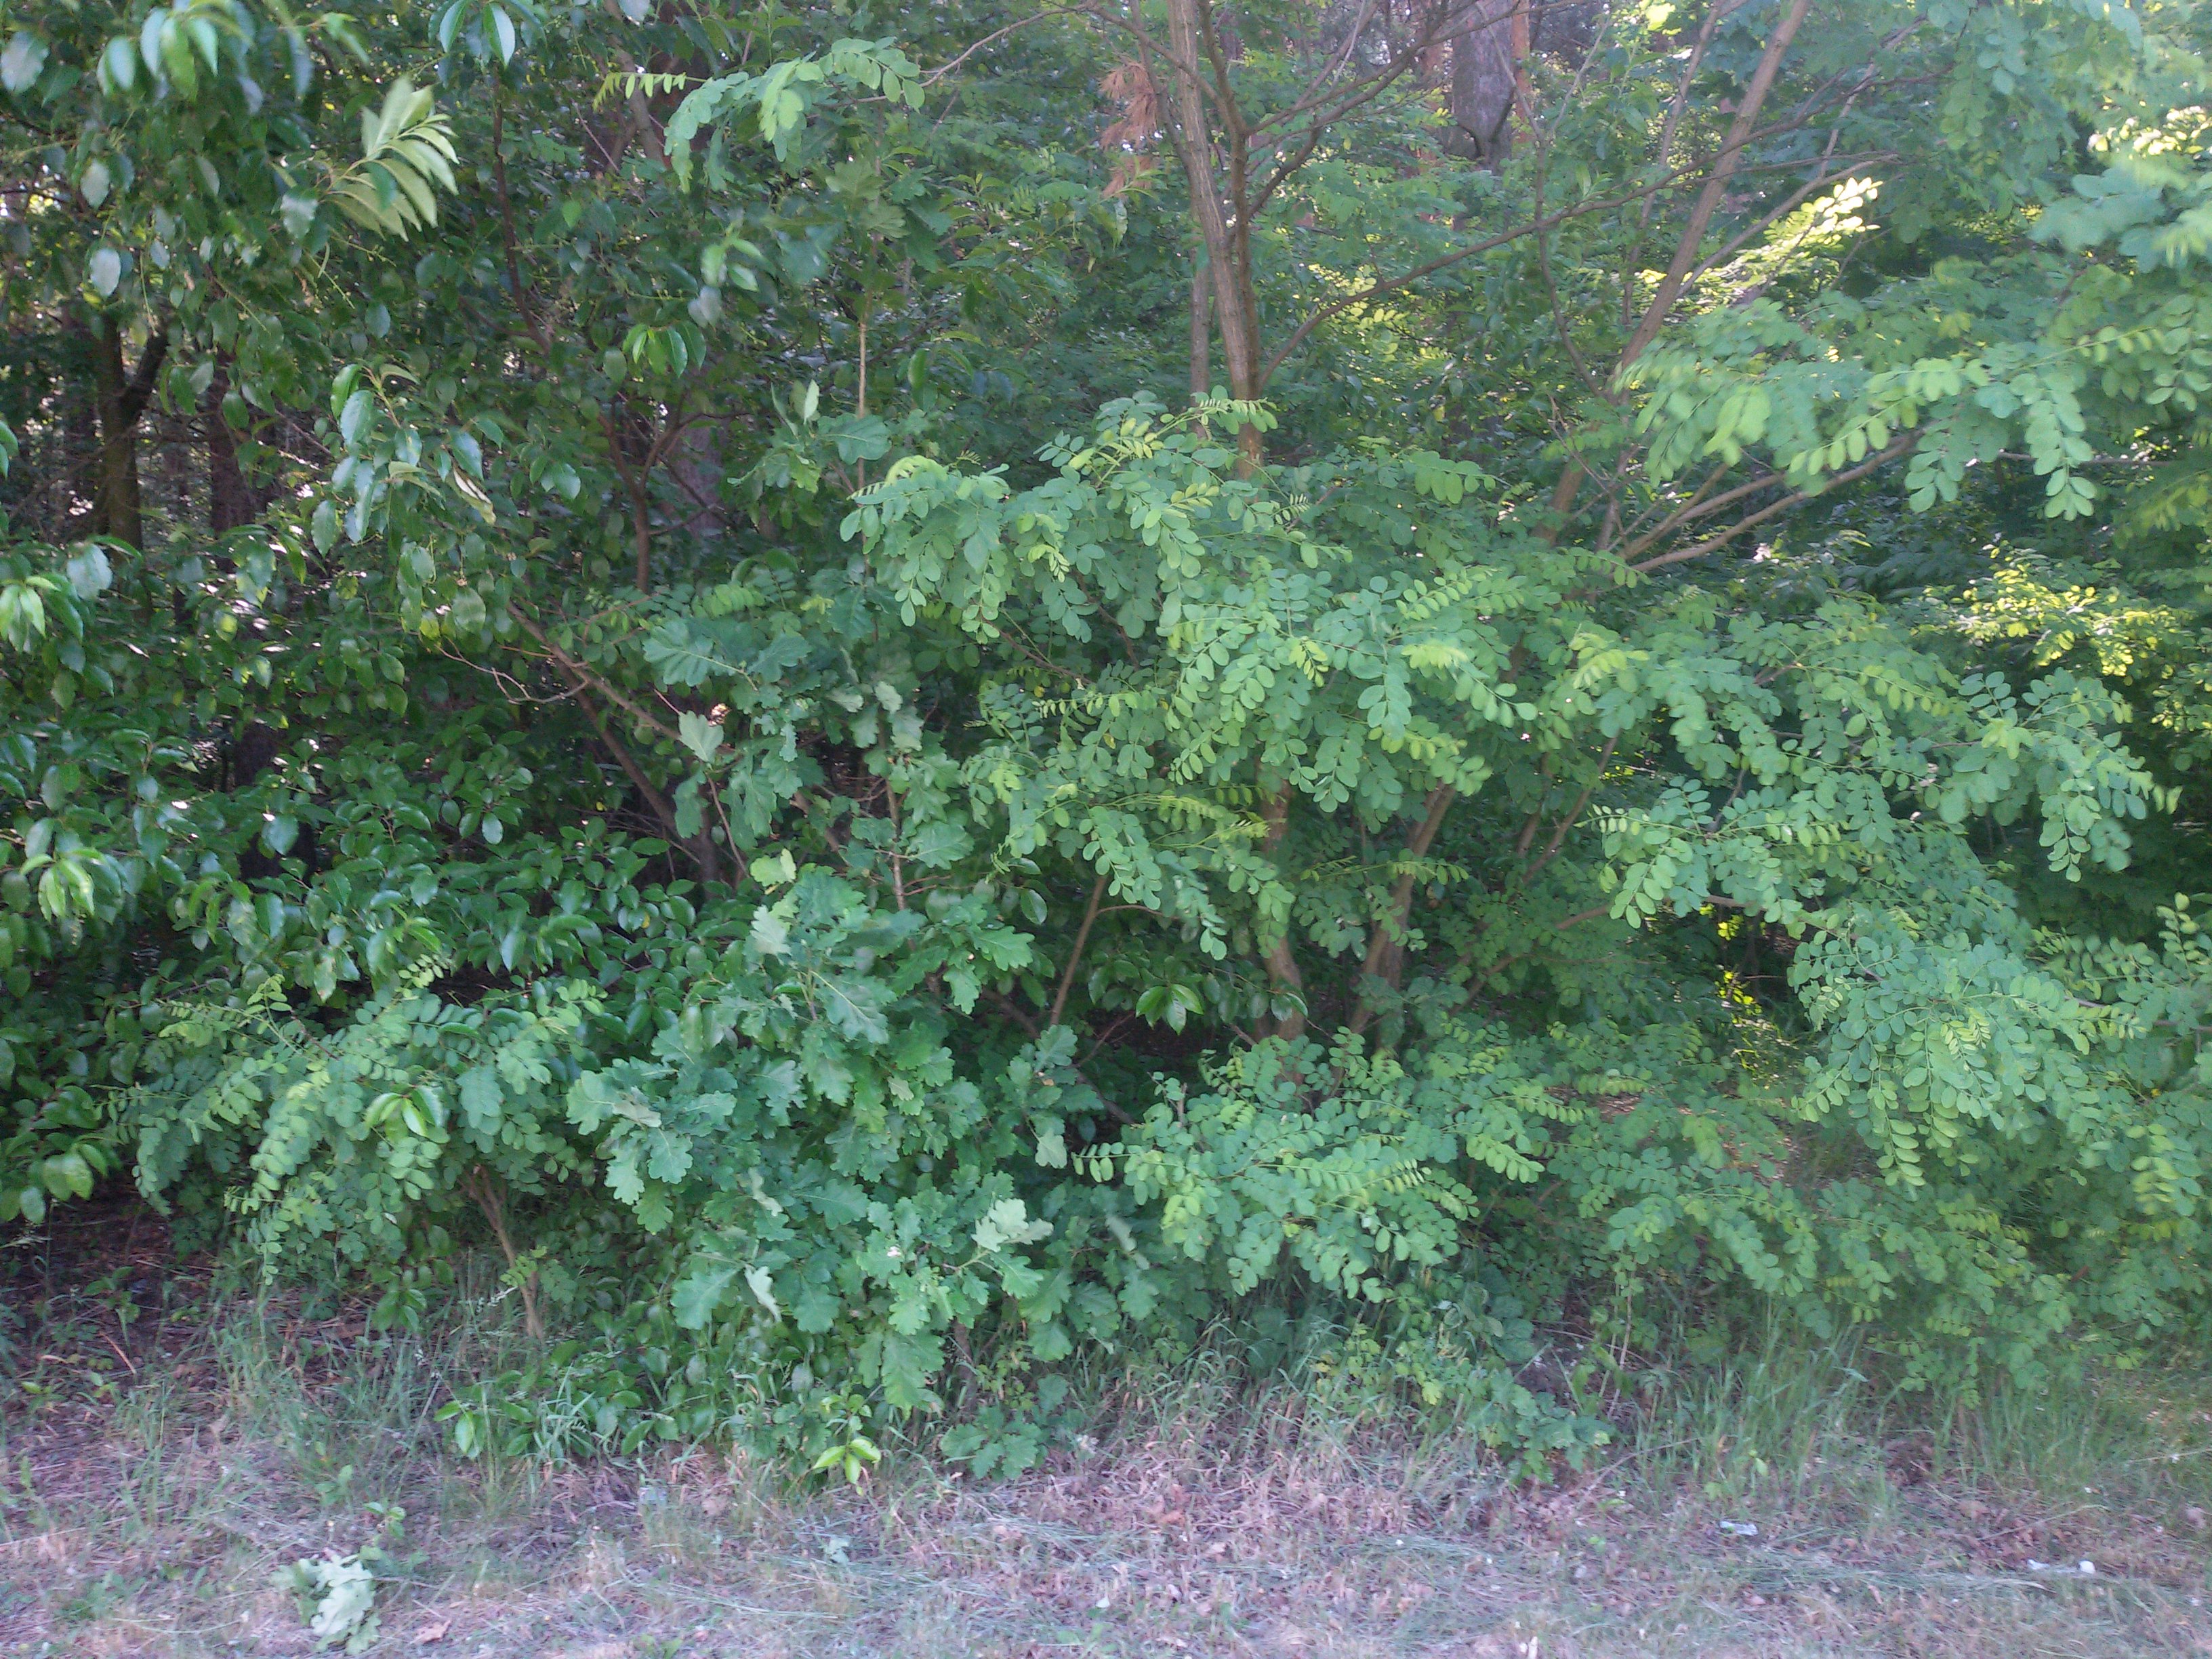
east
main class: Grassland
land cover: Grassland without tree/shrub cover
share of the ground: > 75 %
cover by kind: herbaceous plants 100 %
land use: Sport
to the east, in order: Grassland without tree/shrub cover; Pine dominated mixed woodland; Artificial constructions in urban areas; Other mixed woodland
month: June
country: PL
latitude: 50.1589
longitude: 21.5429
